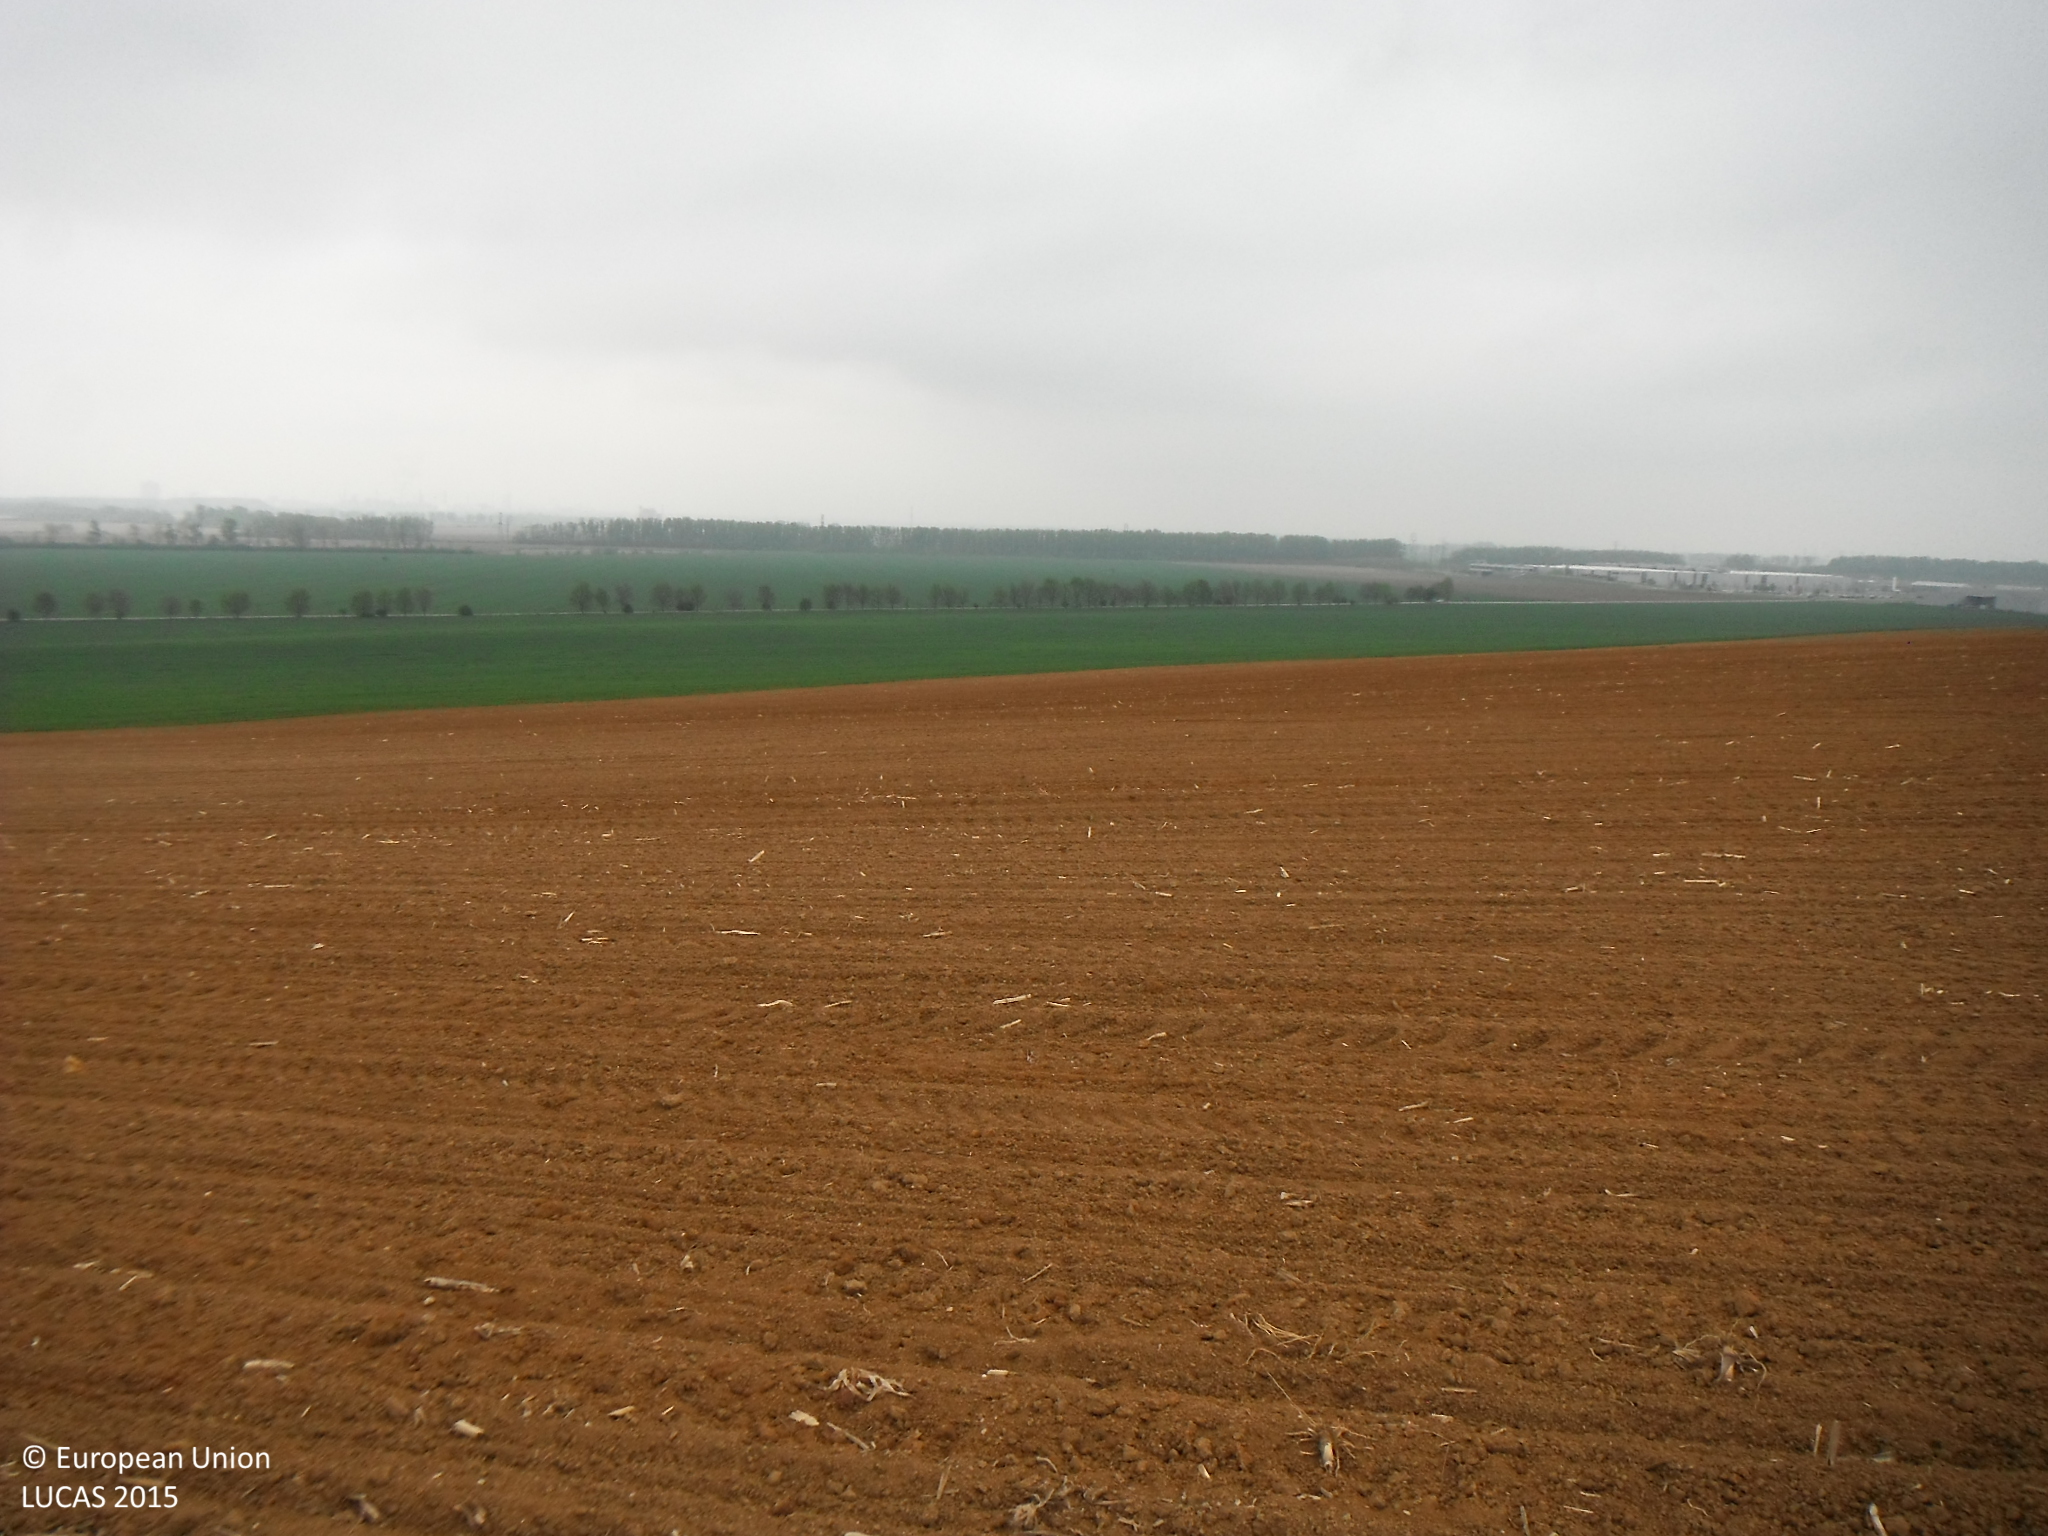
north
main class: Cropland
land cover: Maize
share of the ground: < 10 %
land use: Agriculture (excluding fallow land and kitchen gardens)
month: May
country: SK
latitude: 48.5391
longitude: 21.2174
